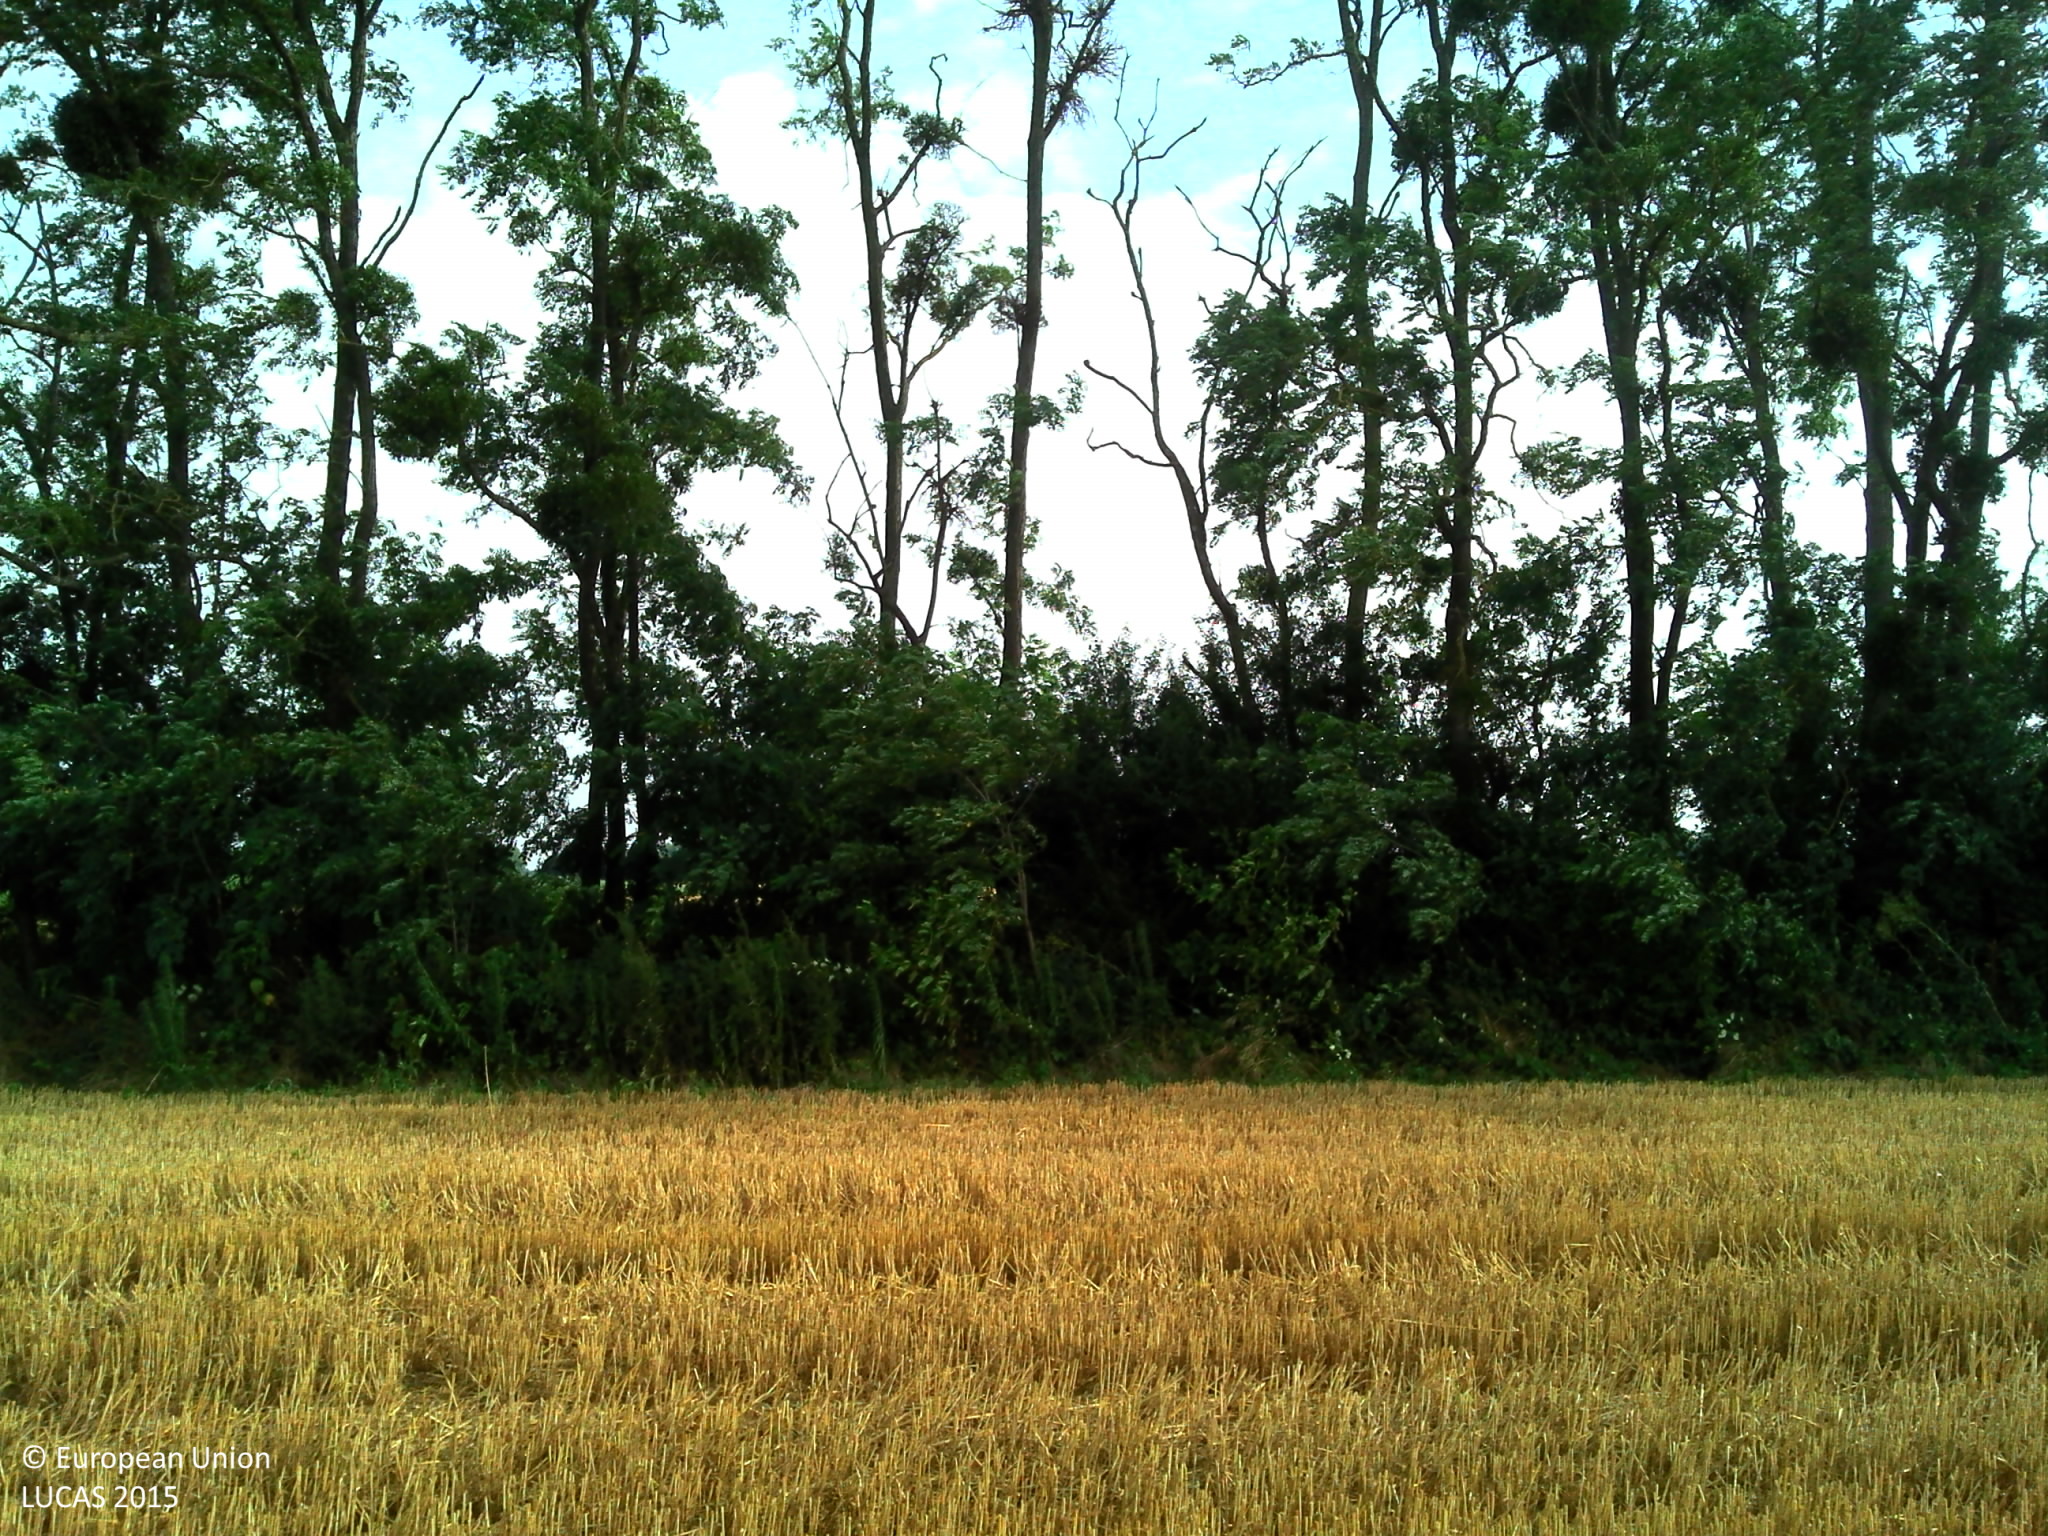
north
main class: Cropland
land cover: Common wheat
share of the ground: > 75 %
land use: Agriculture (excluding fallow land and kitchen gardens)
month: July
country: FR
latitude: 43.2136
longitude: 1.6228
